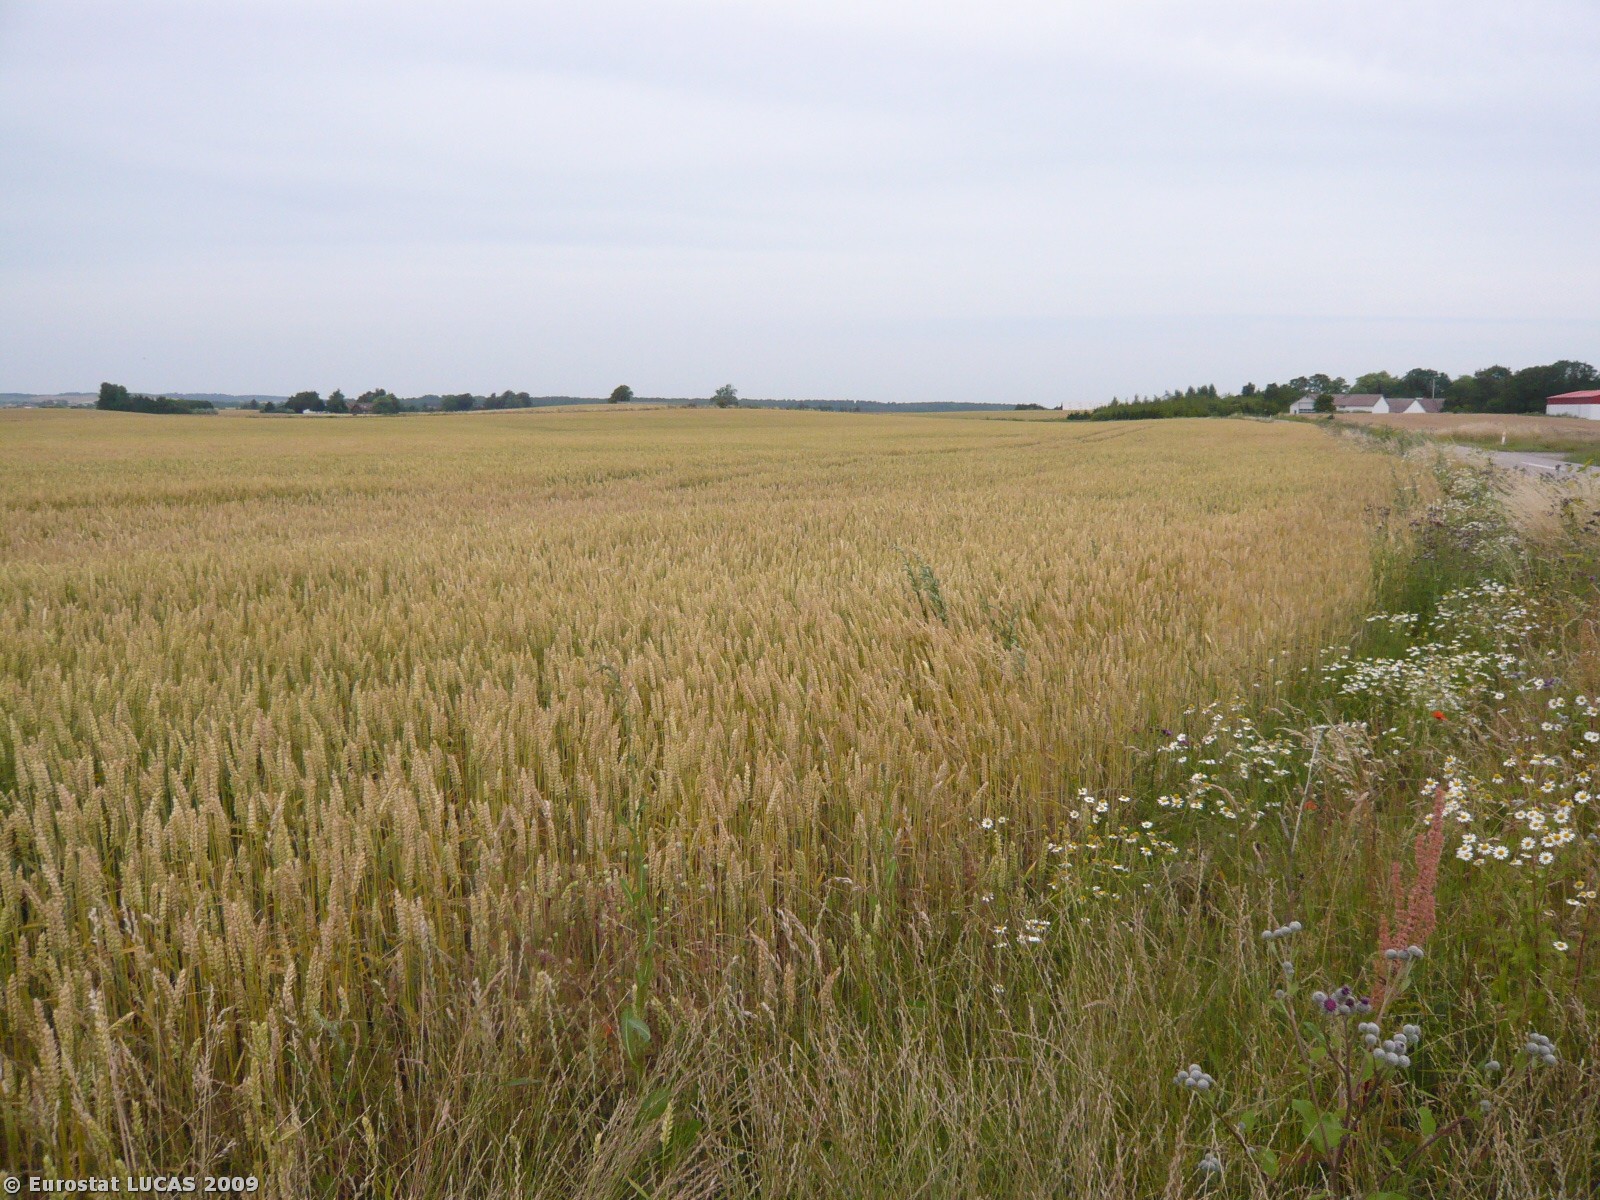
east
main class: Cropland
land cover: Common wheat
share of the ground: > 75 %
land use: Agriculture (excluding fallow land and kitchen gardens)
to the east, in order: Common wheat
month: July
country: DK
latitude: 55.5648
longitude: 11.7269
